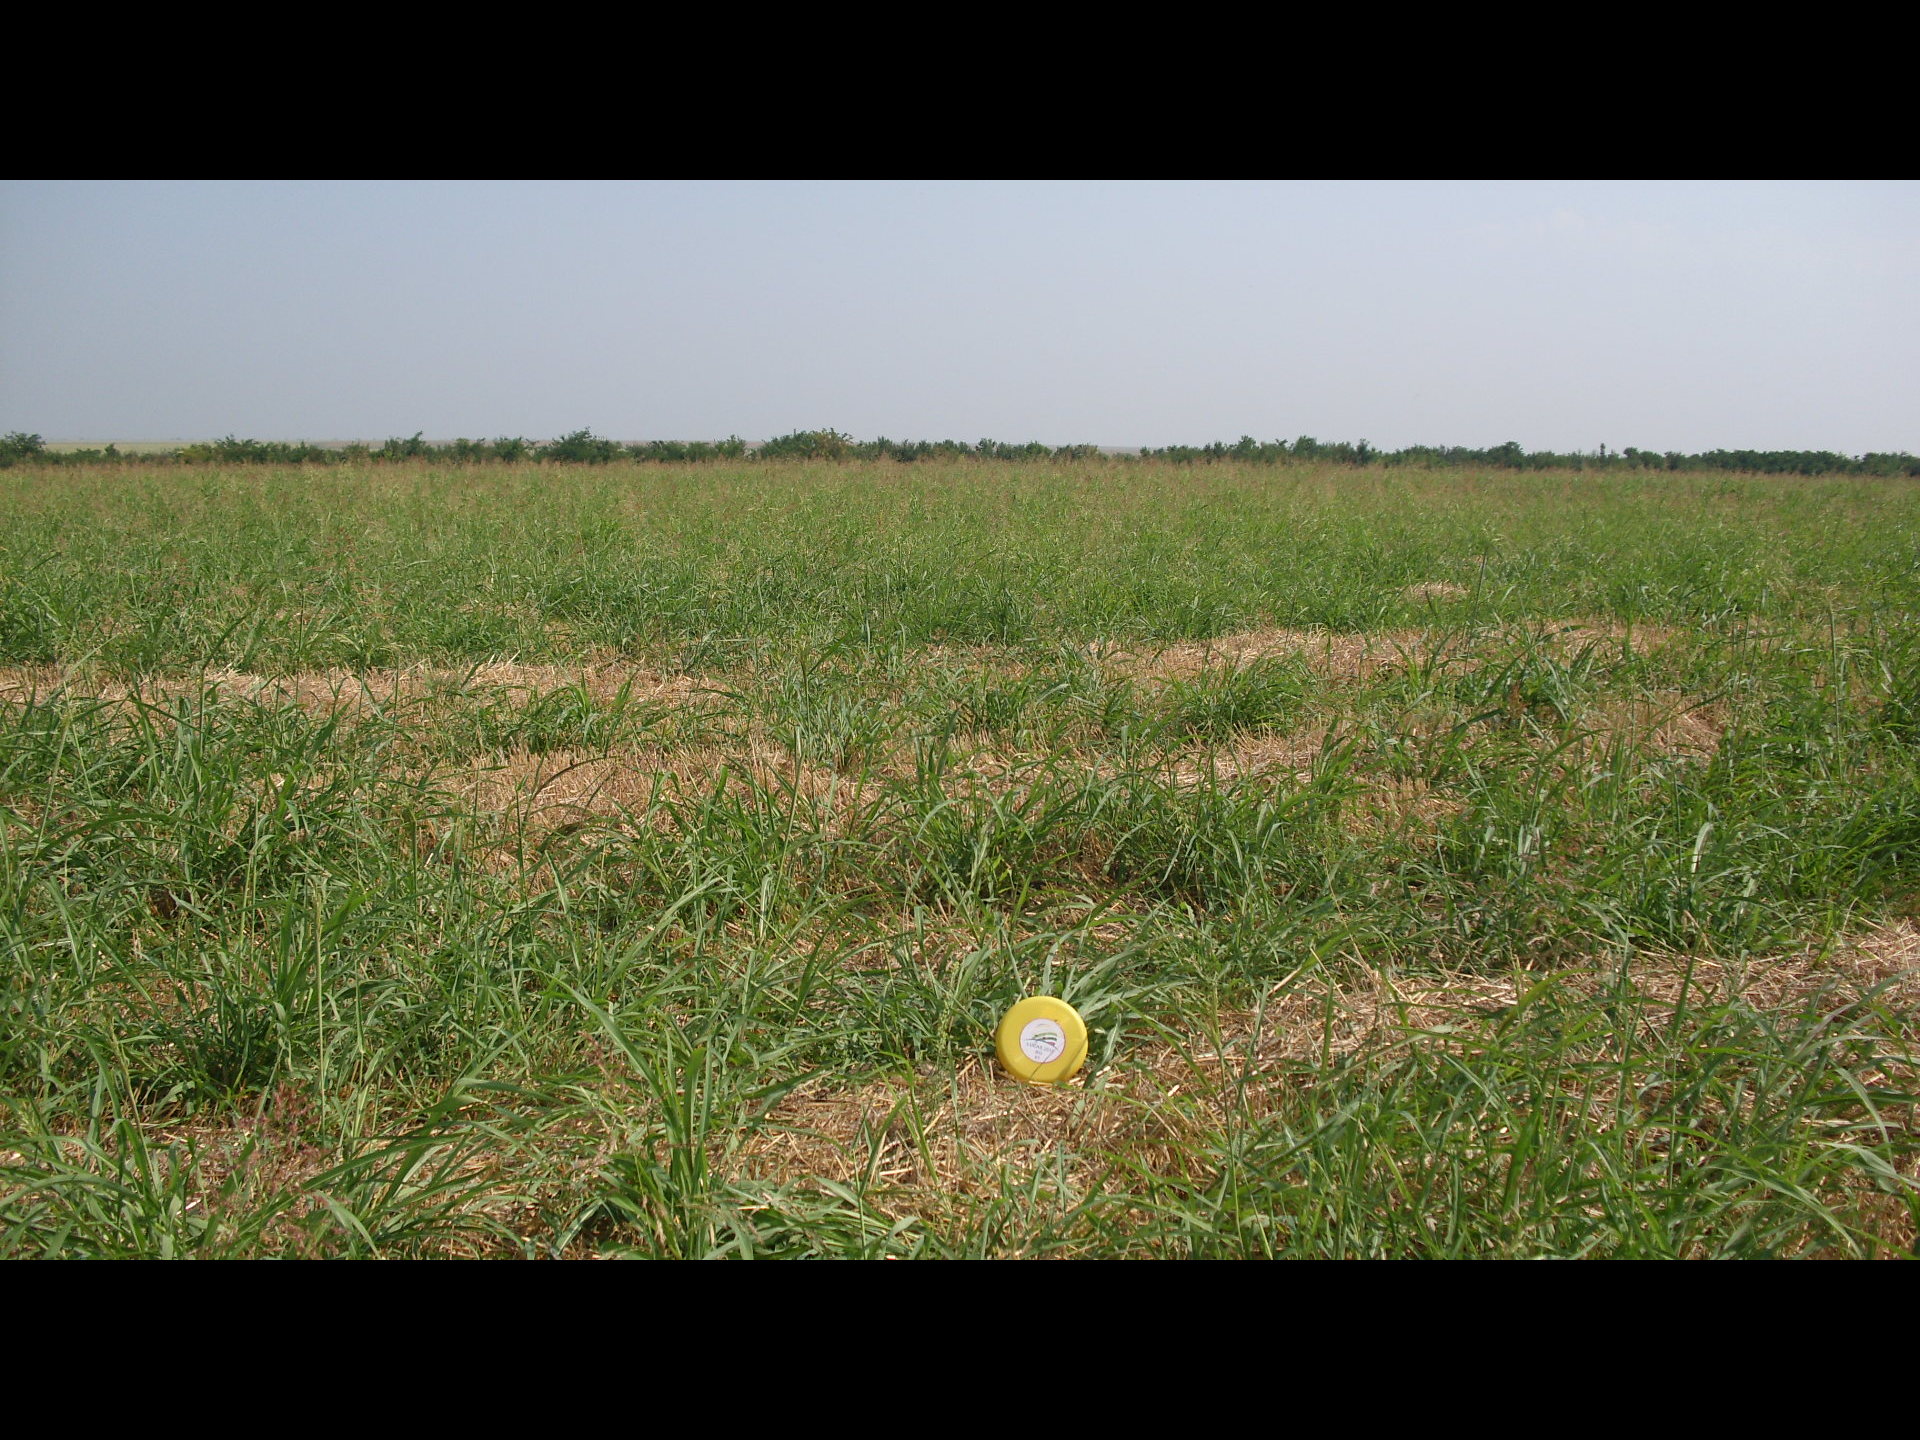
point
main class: Cropland
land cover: Barley
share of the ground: > 75 %
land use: Agriculture (excluding fallow land and kitchen gardens)
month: July
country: BG
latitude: 43.7289
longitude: 23.5671
